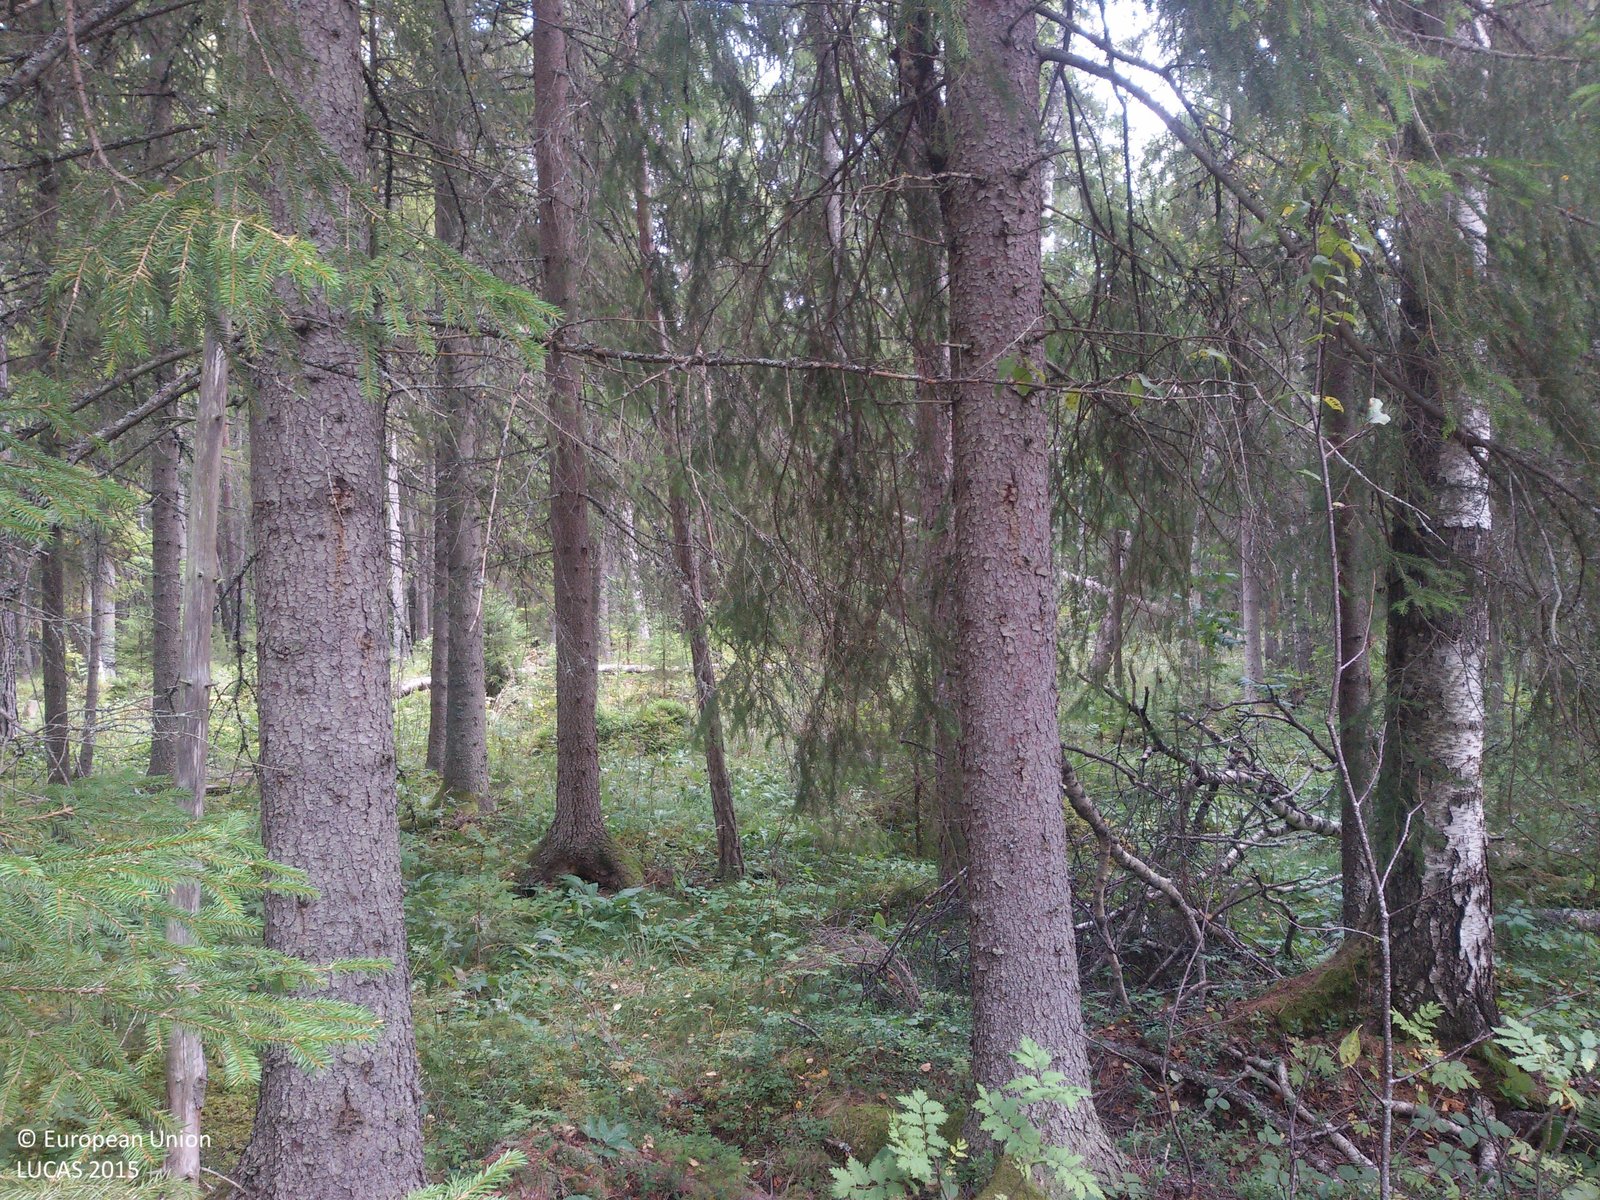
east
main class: Woodland
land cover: Spruce dominated mixed woodland
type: boreal forest
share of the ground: > 75 %
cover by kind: coniferous forest trees 60 %, broadleaved forest trees 20 %, herbaceous plants 10 %, lichens and mosses 10 %
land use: Forestry
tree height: > 5 m
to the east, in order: Spruce dominated mixed woodland; Spruce dominated coniferous woodland; Spontaneously vegetated surfaces
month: September
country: SE
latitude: 60.9136
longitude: 15.2419
